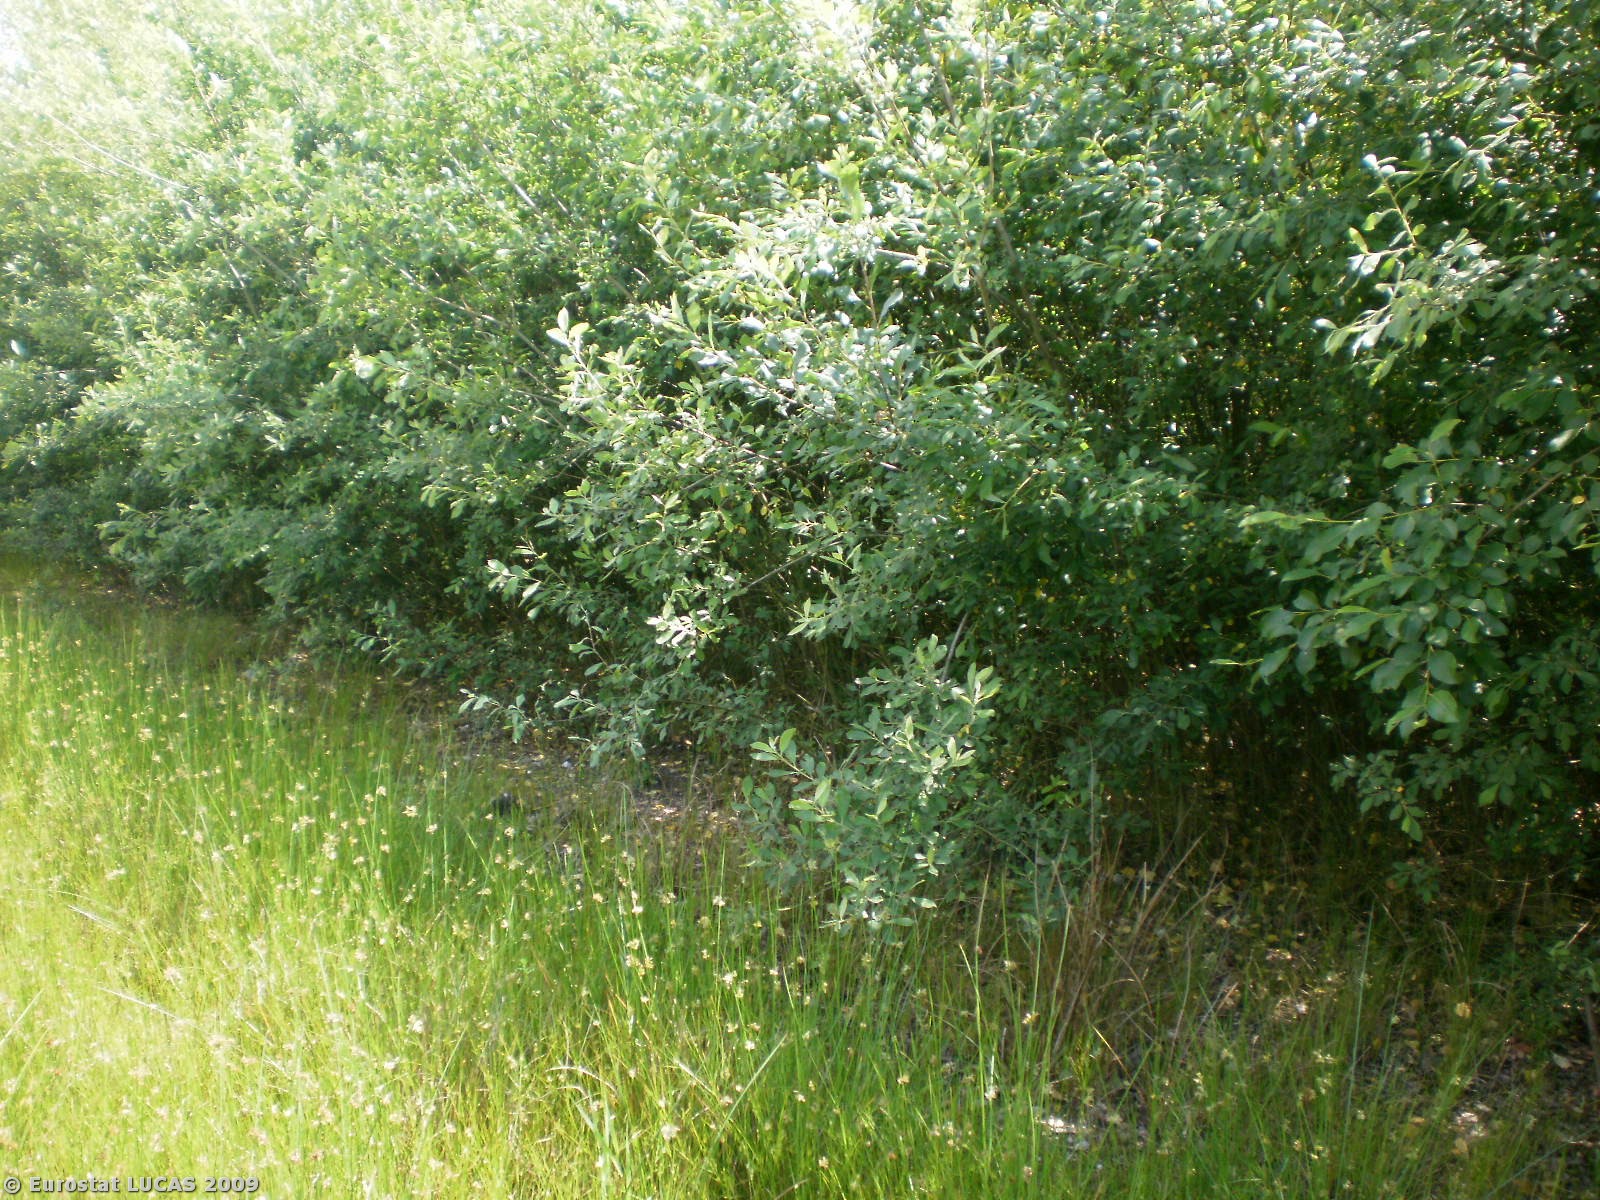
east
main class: Grassland
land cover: Grassland without tree/shrub cover
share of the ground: > 75 %
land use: Unused
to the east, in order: Grassland without tree/shrub cover; Broadleaved woodland; Grassland with sparse tree/shrub cover
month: June
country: BE
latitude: 50.9940
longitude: 5.4530
